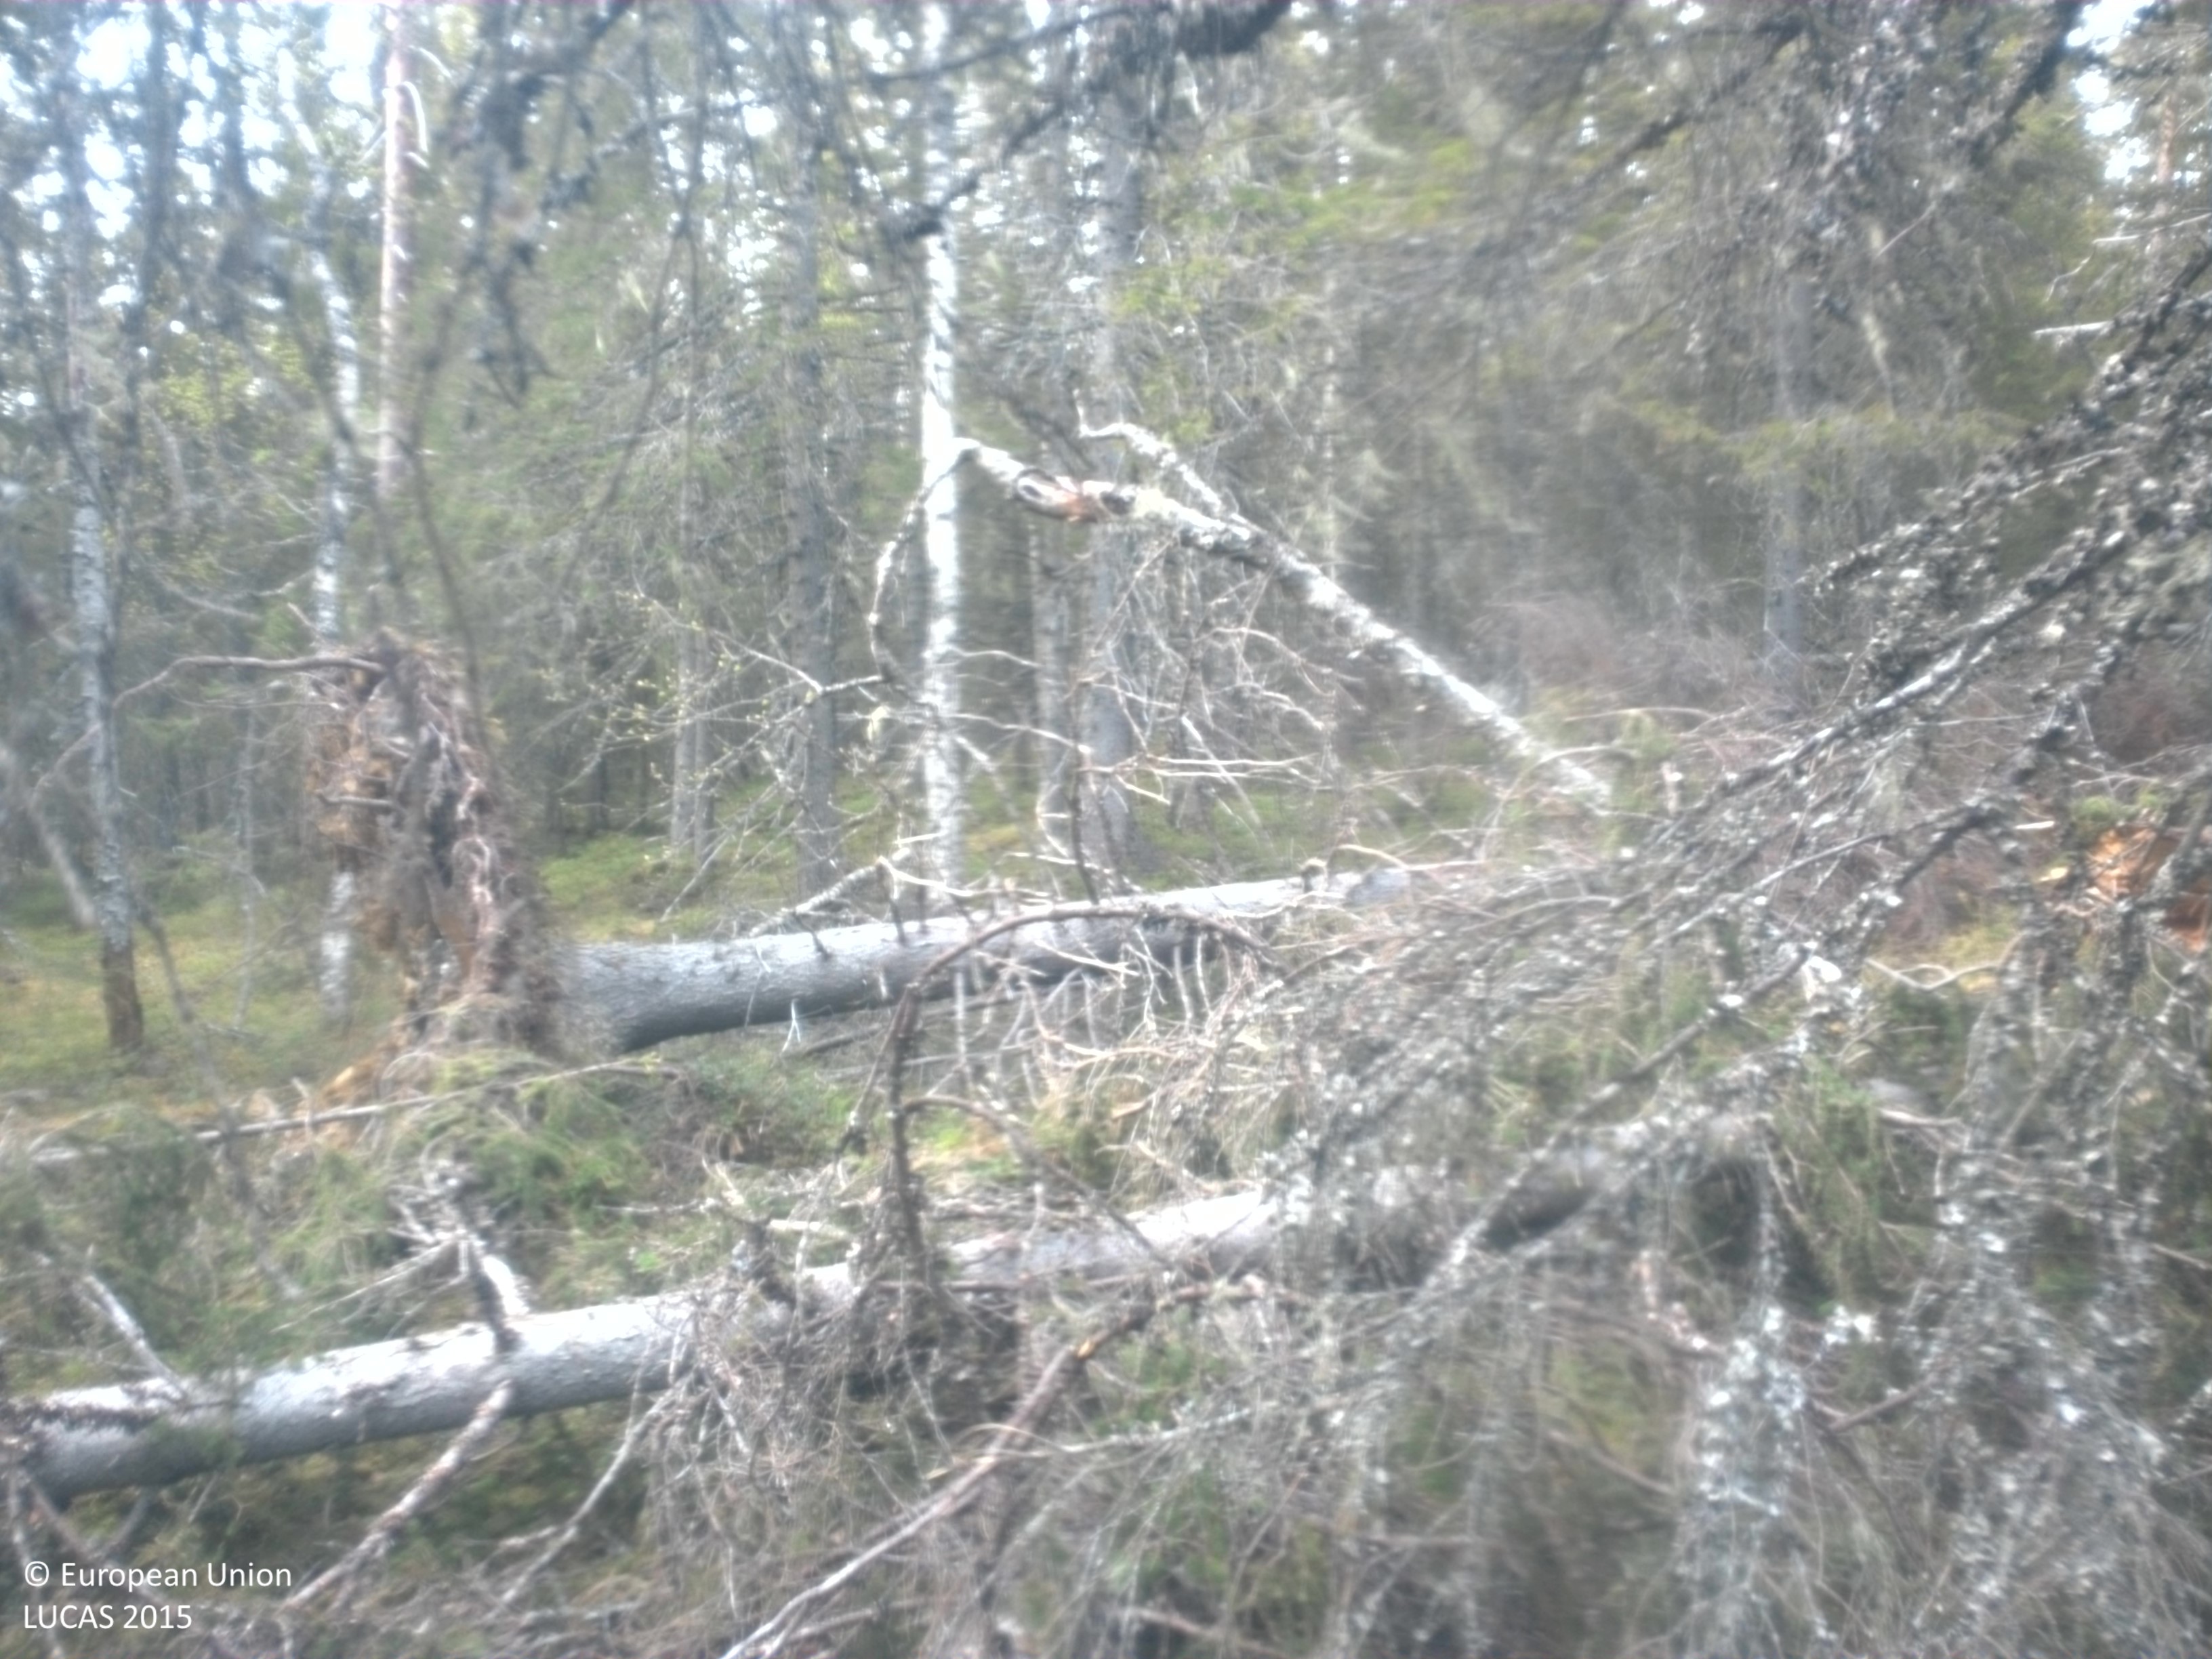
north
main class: Woodland
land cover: Spruce dominated coniferous woodland
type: boreal forest
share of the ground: 25 - 50 %
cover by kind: coniferous forest trees 45 %, herbaceous plants 25 %, lichens and mosses 10 %, unconsolidated bare surface 10 %, broadleaved forest trees 5 %, shrubs 5 %
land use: Forestry
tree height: > 5 m
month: June
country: SE
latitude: 64.4463
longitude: 17.7178
